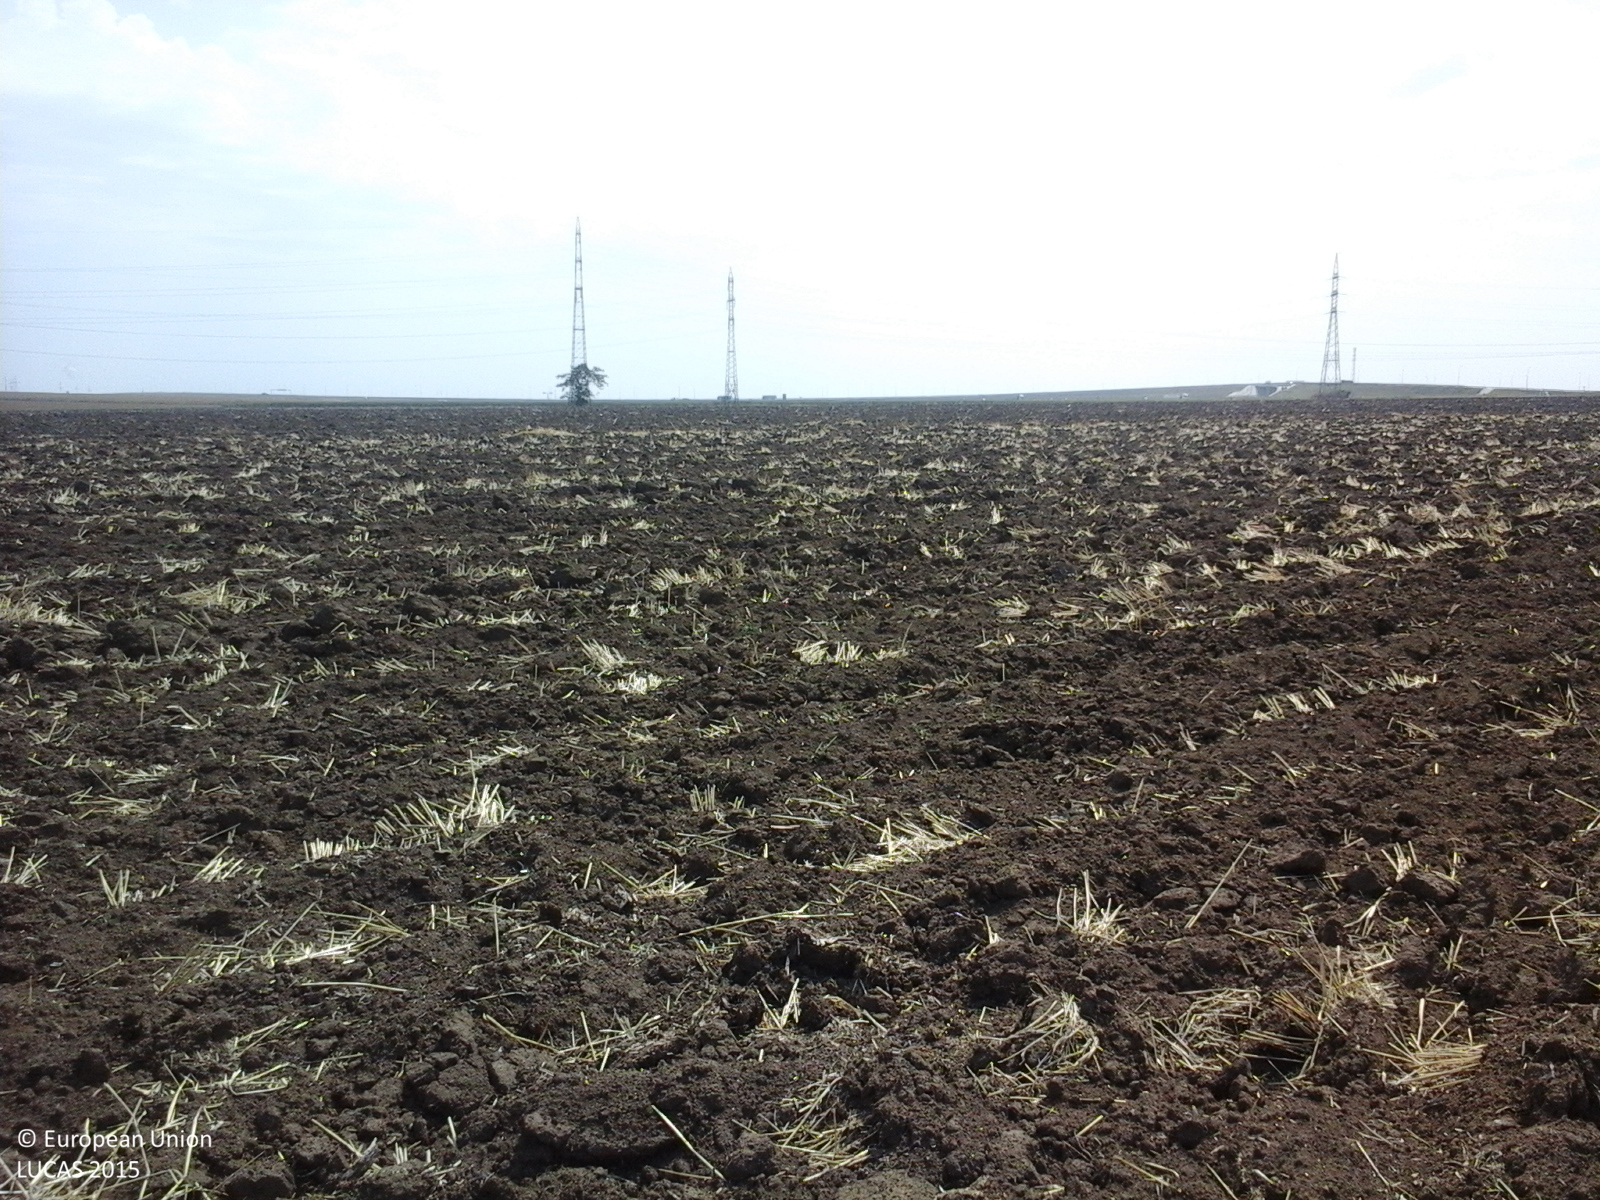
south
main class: Cropland
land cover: Common wheat
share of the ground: < 10 %
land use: Agriculture (excluding fallow land and kitchen gardens)
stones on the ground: < 10 %
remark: Harvested field
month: August
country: RO
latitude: 44.1534
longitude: 28.5637
